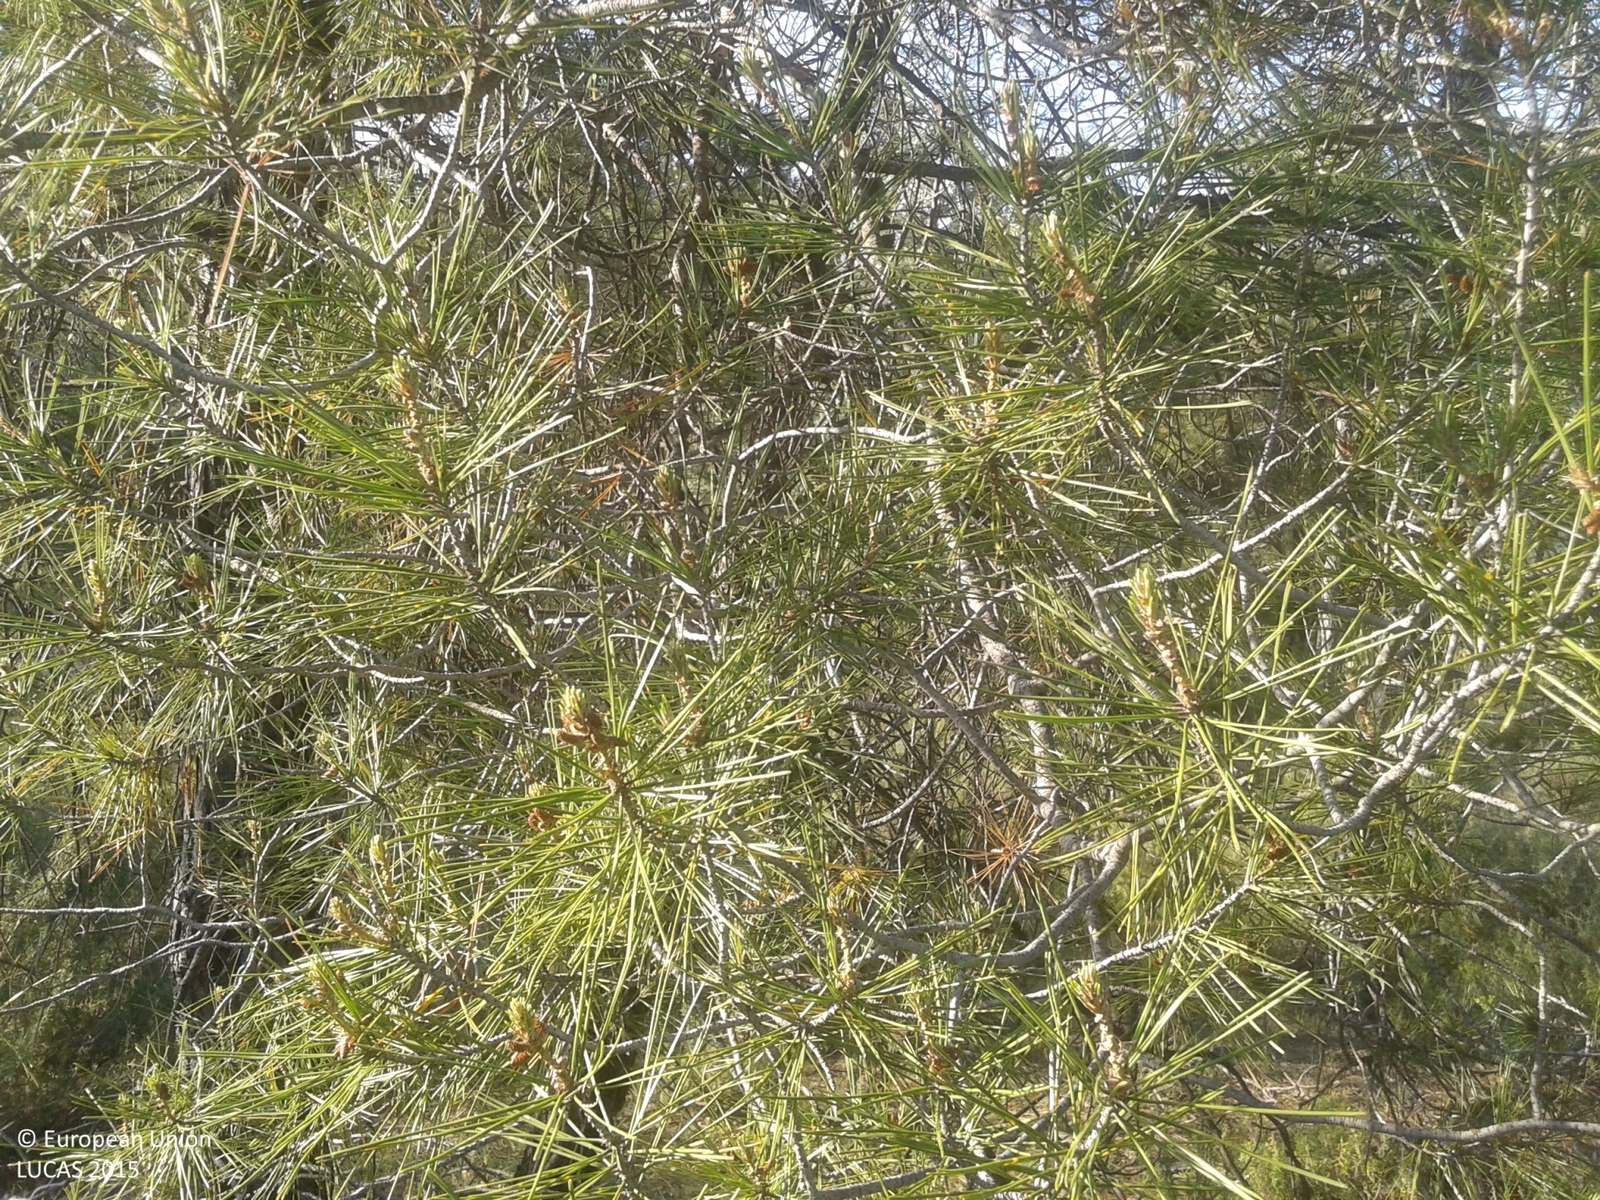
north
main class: Woodland
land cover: Pine dominated mixed woodland
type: coniferous forest of the mediterranean region
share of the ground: > 75 %
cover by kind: coniferous forest trees 60 %, broadleaved forest trees 20 %, shrubs 10 %, herbaceous plants 10 %
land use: Forestry
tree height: > 5 m
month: June
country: ES
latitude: 41.9620
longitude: 1.6275
